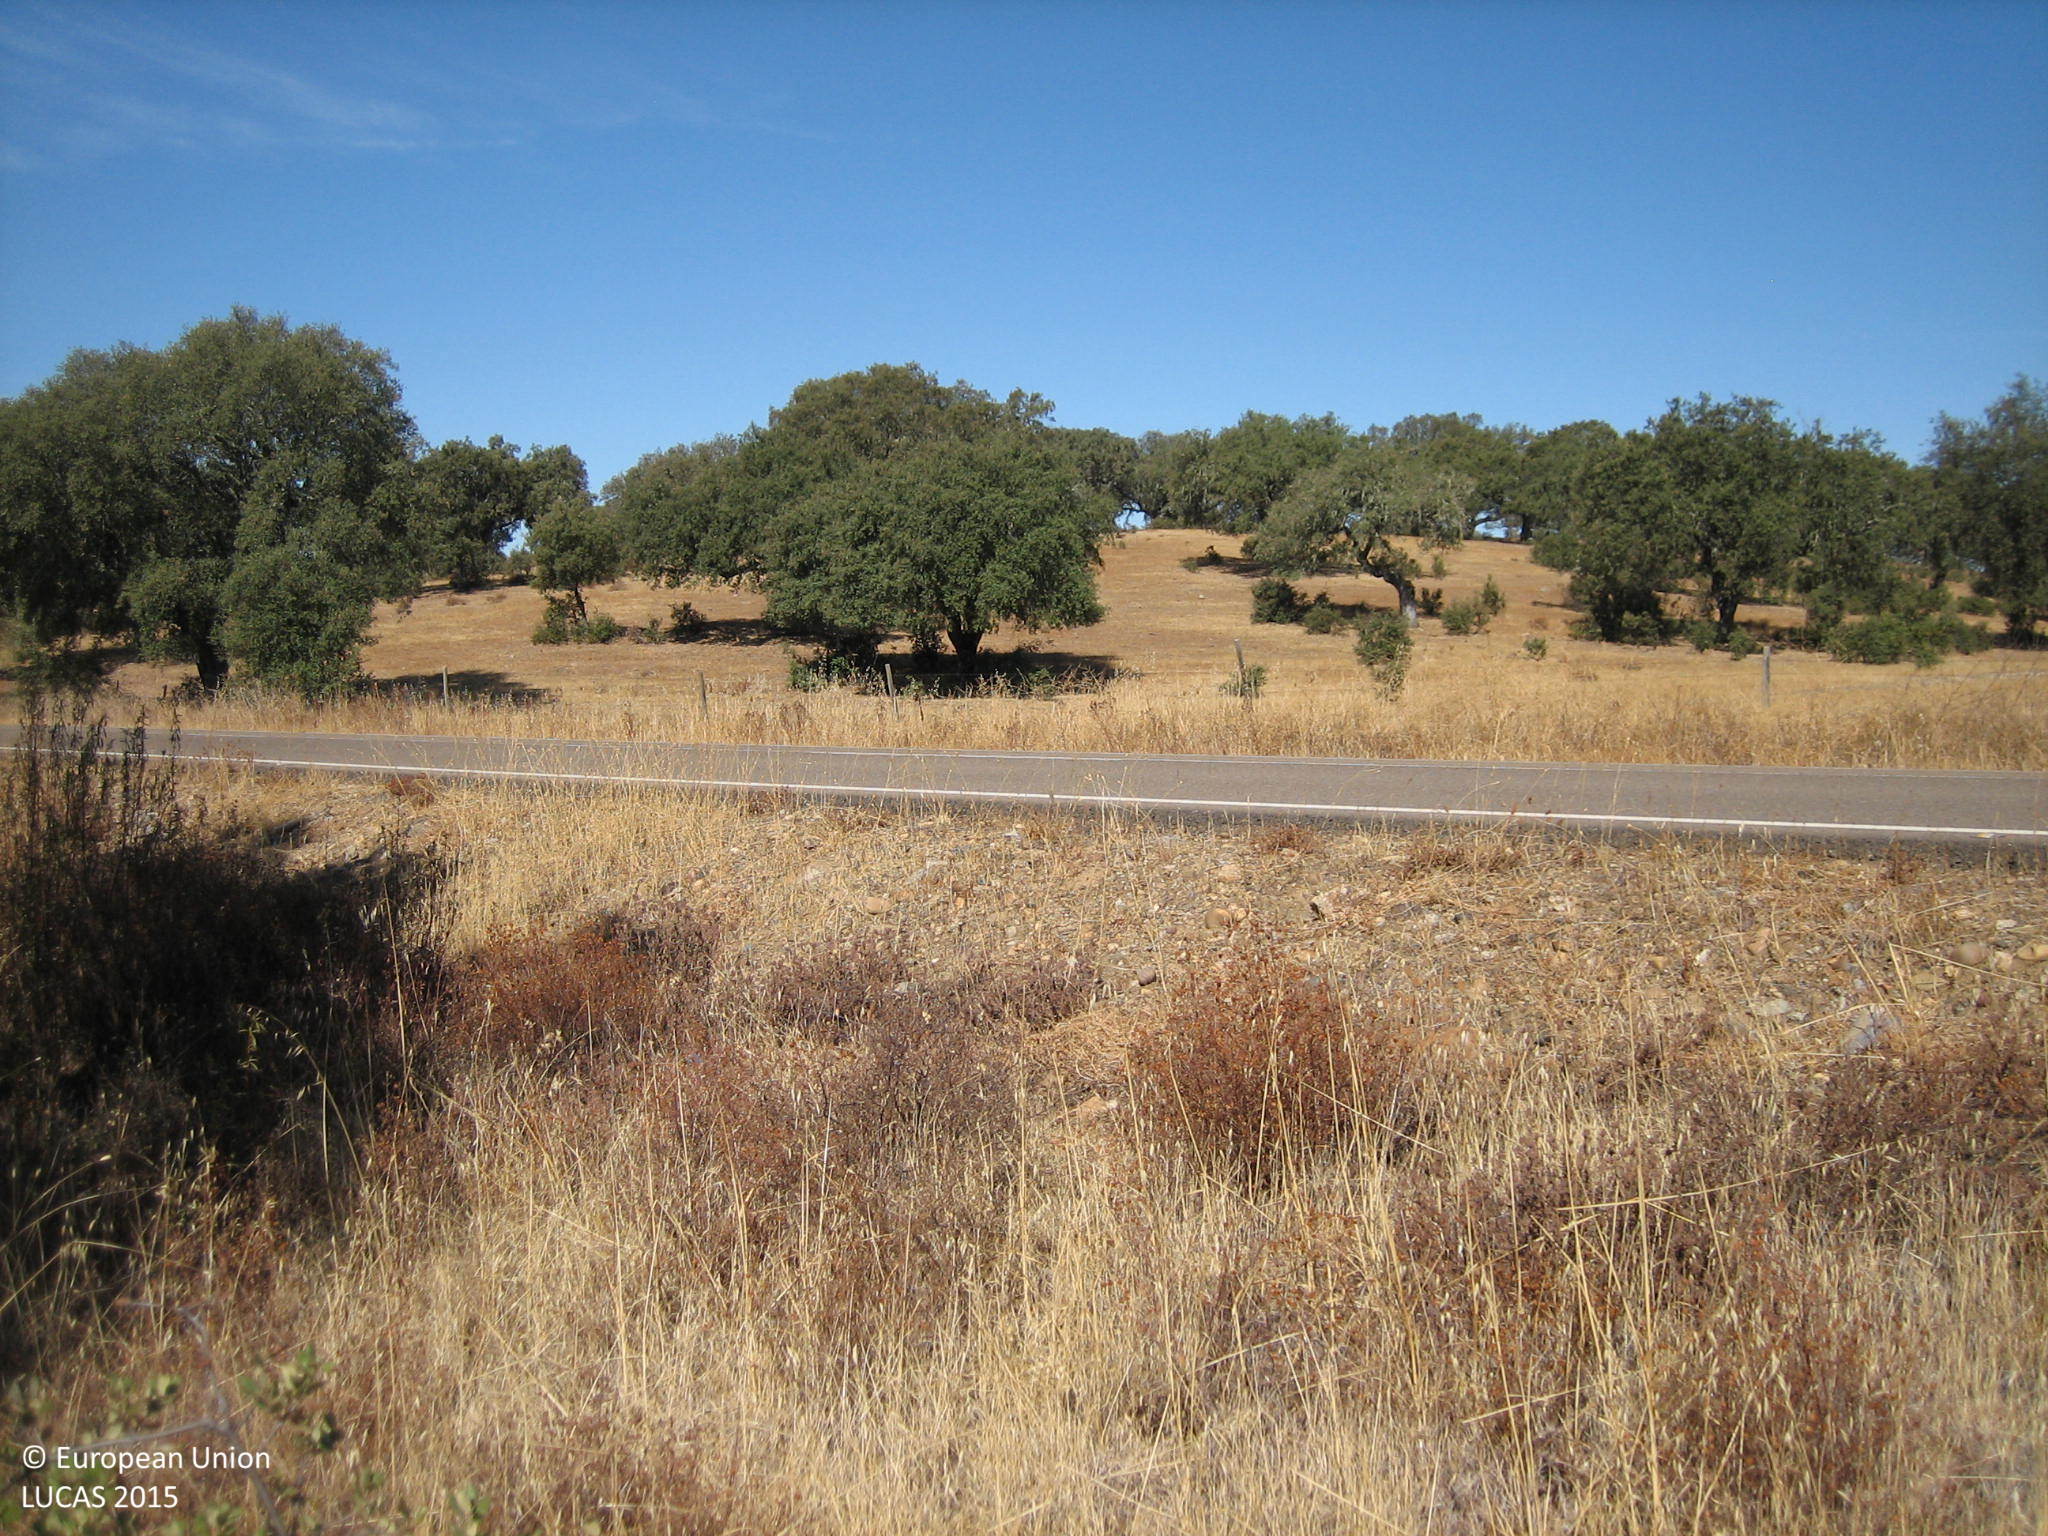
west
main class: Woodland
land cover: Broadleaved woodland
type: broadleaved evergreen forest
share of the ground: 10 - 25 %
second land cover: Shrubland without tree cover
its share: 10 - 25 %
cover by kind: herbaceous plants 40 %, broadleaved forest trees 20 %, shrubs 20 %, unconsolidated bare surface 20 %
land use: Forestry
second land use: Agriculture (excluding fallow land and kitchen gardens)
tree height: > 5 m
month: August
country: ES
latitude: 38.5115
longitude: -7.2132
